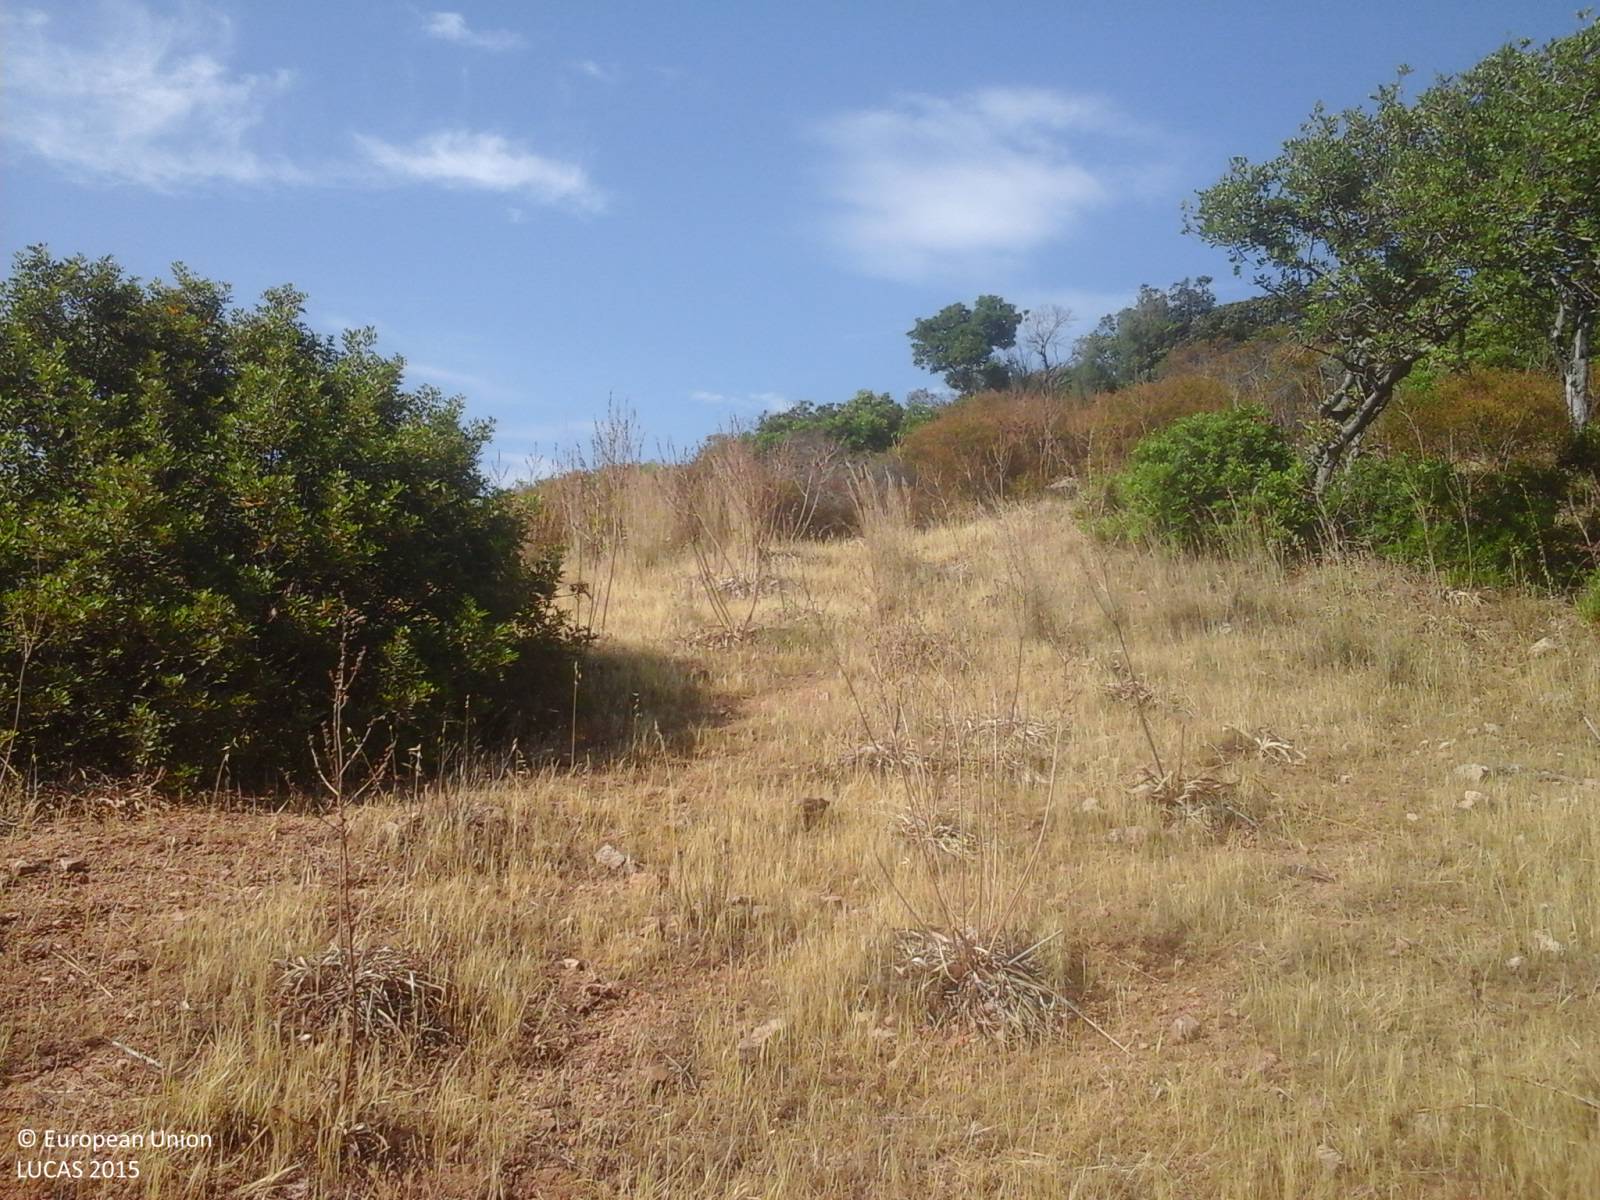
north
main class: Shrubland
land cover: Shrubland with sparse tree cover
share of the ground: > 75 %
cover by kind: shrubs 60 %, herbaceous plants 30 %, broadleaved forest trees 5 %, unconsolidated bare surface 5 %
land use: Agriculture (excluding fallow land and kitchen gardens)
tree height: < 5 m
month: June
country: IT
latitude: 39.1609
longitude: 9.4595
